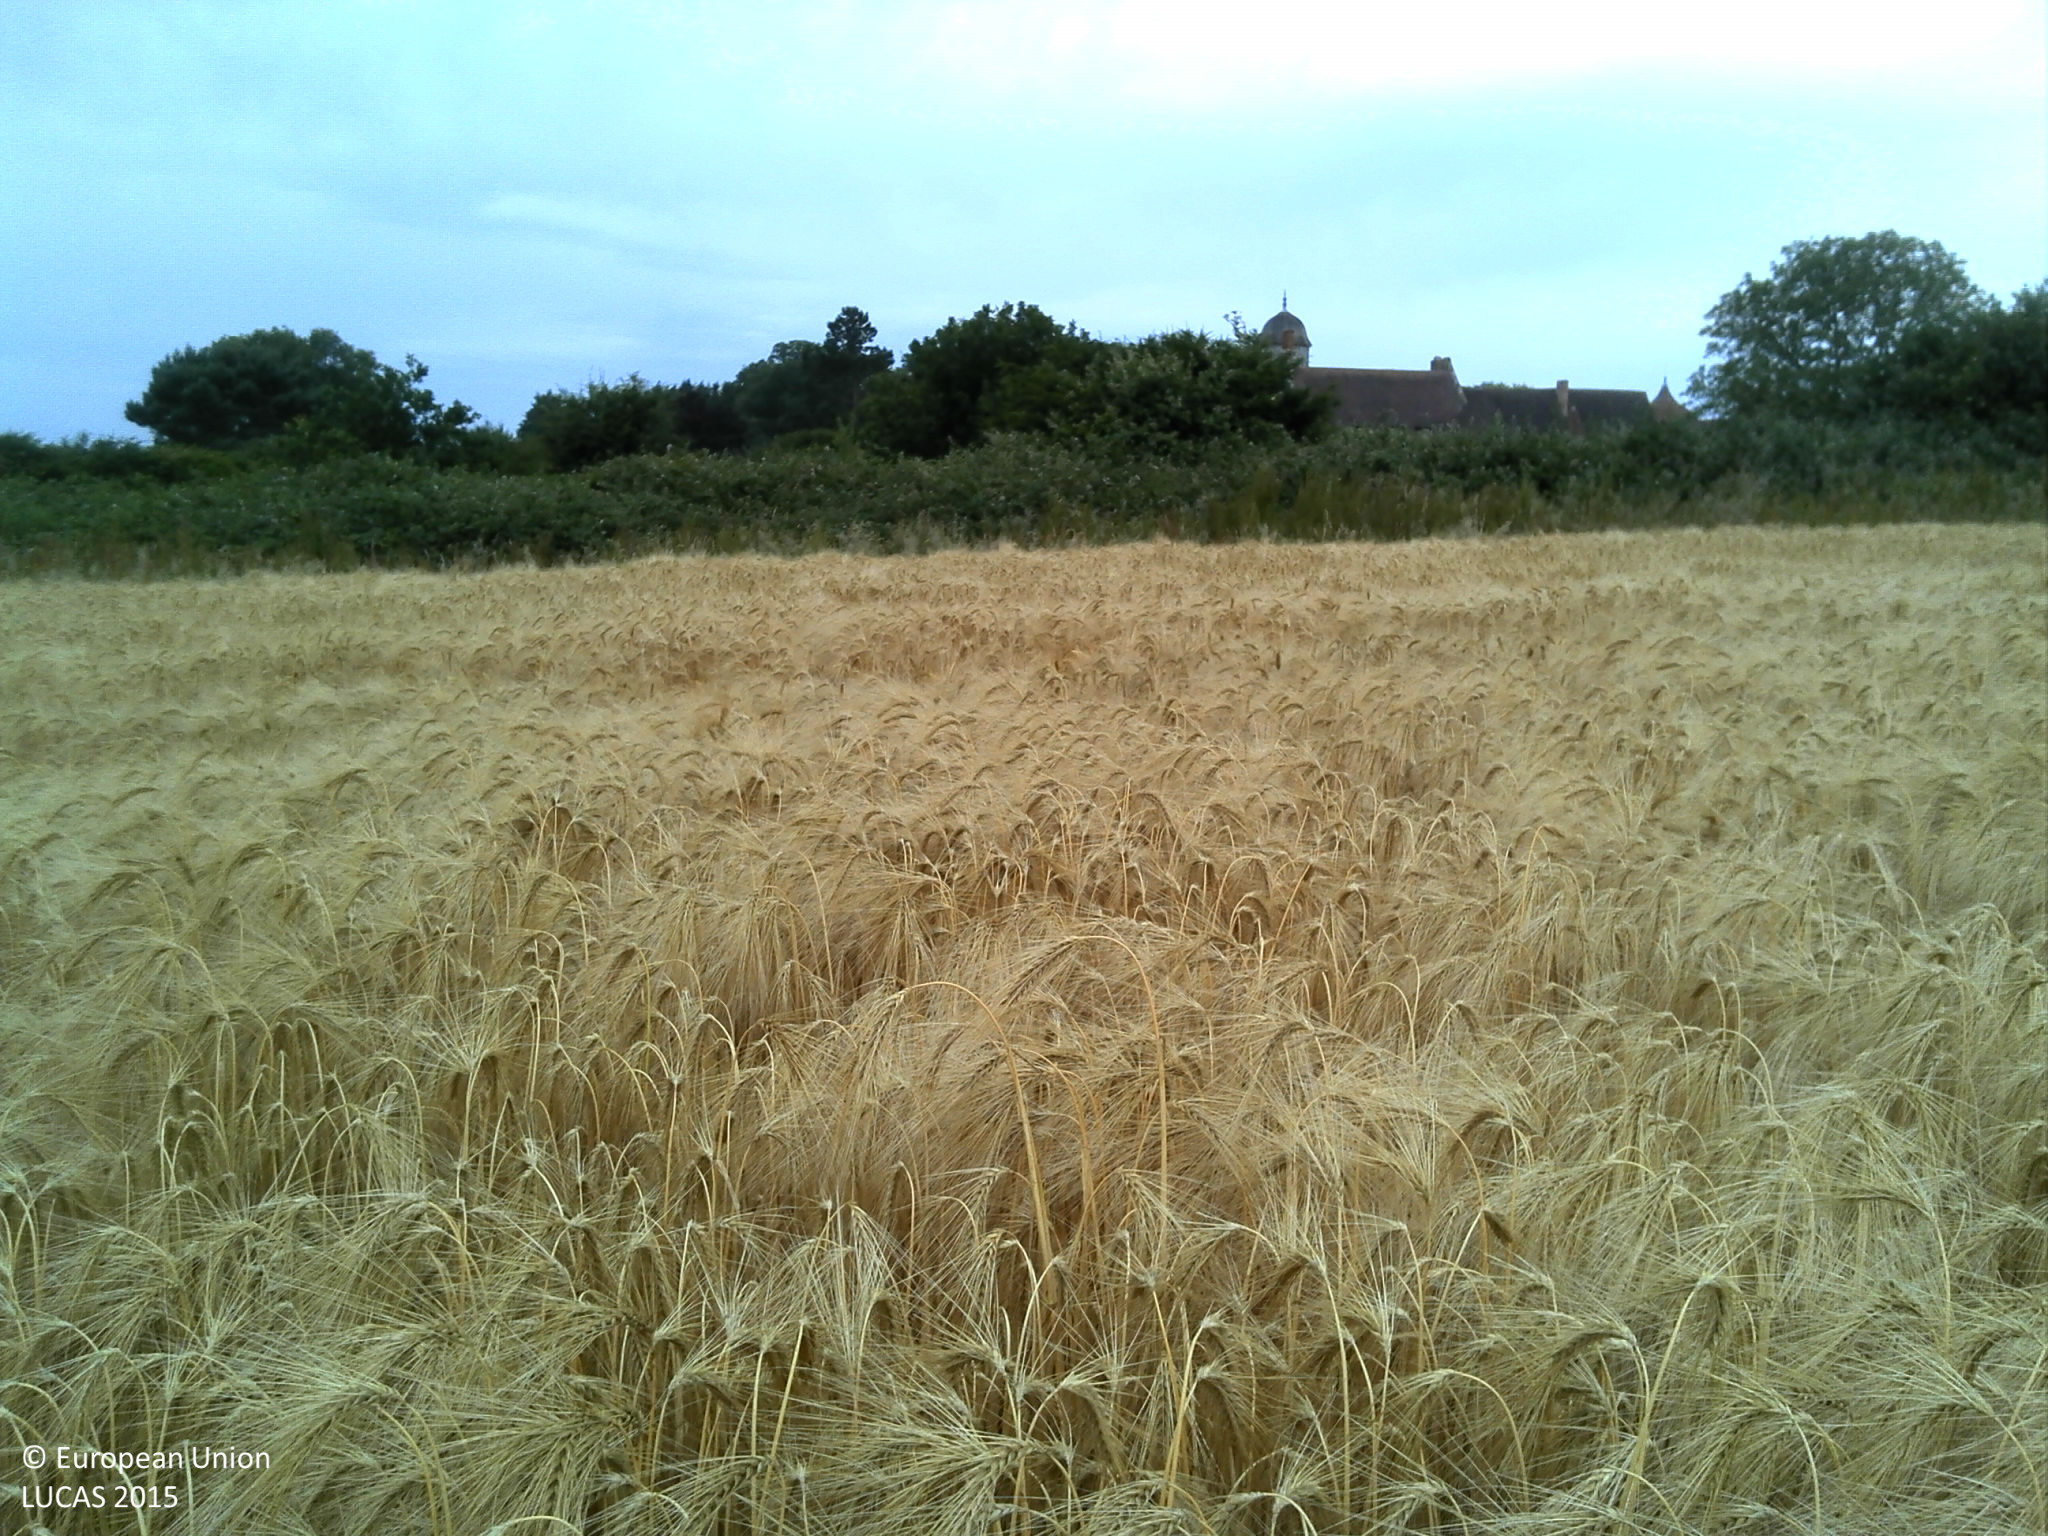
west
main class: Cropland
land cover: Barley
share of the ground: > 75 %
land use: Agriculture (excluding fallow land and kitchen gardens)
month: July
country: FR
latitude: 49.8999
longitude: 0.9975
